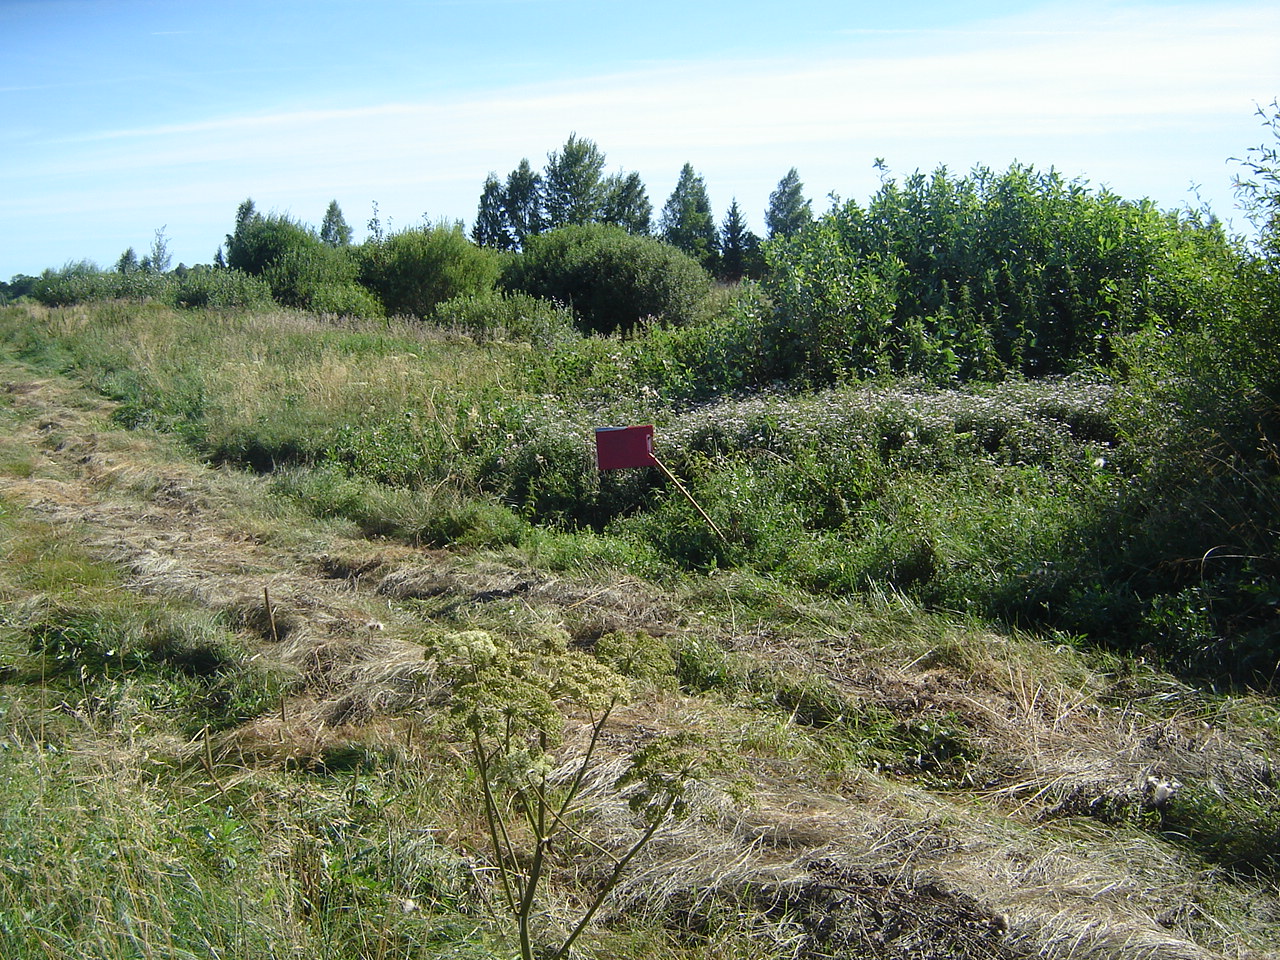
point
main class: Grassland
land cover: Grassland without tree/shrub cover
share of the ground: > 75 %
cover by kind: herbaceous plants 100 %
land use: Agriculture (excluding fallow land and kitchen gardens)
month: August
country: LT
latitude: 54.8826
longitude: 25.2556
